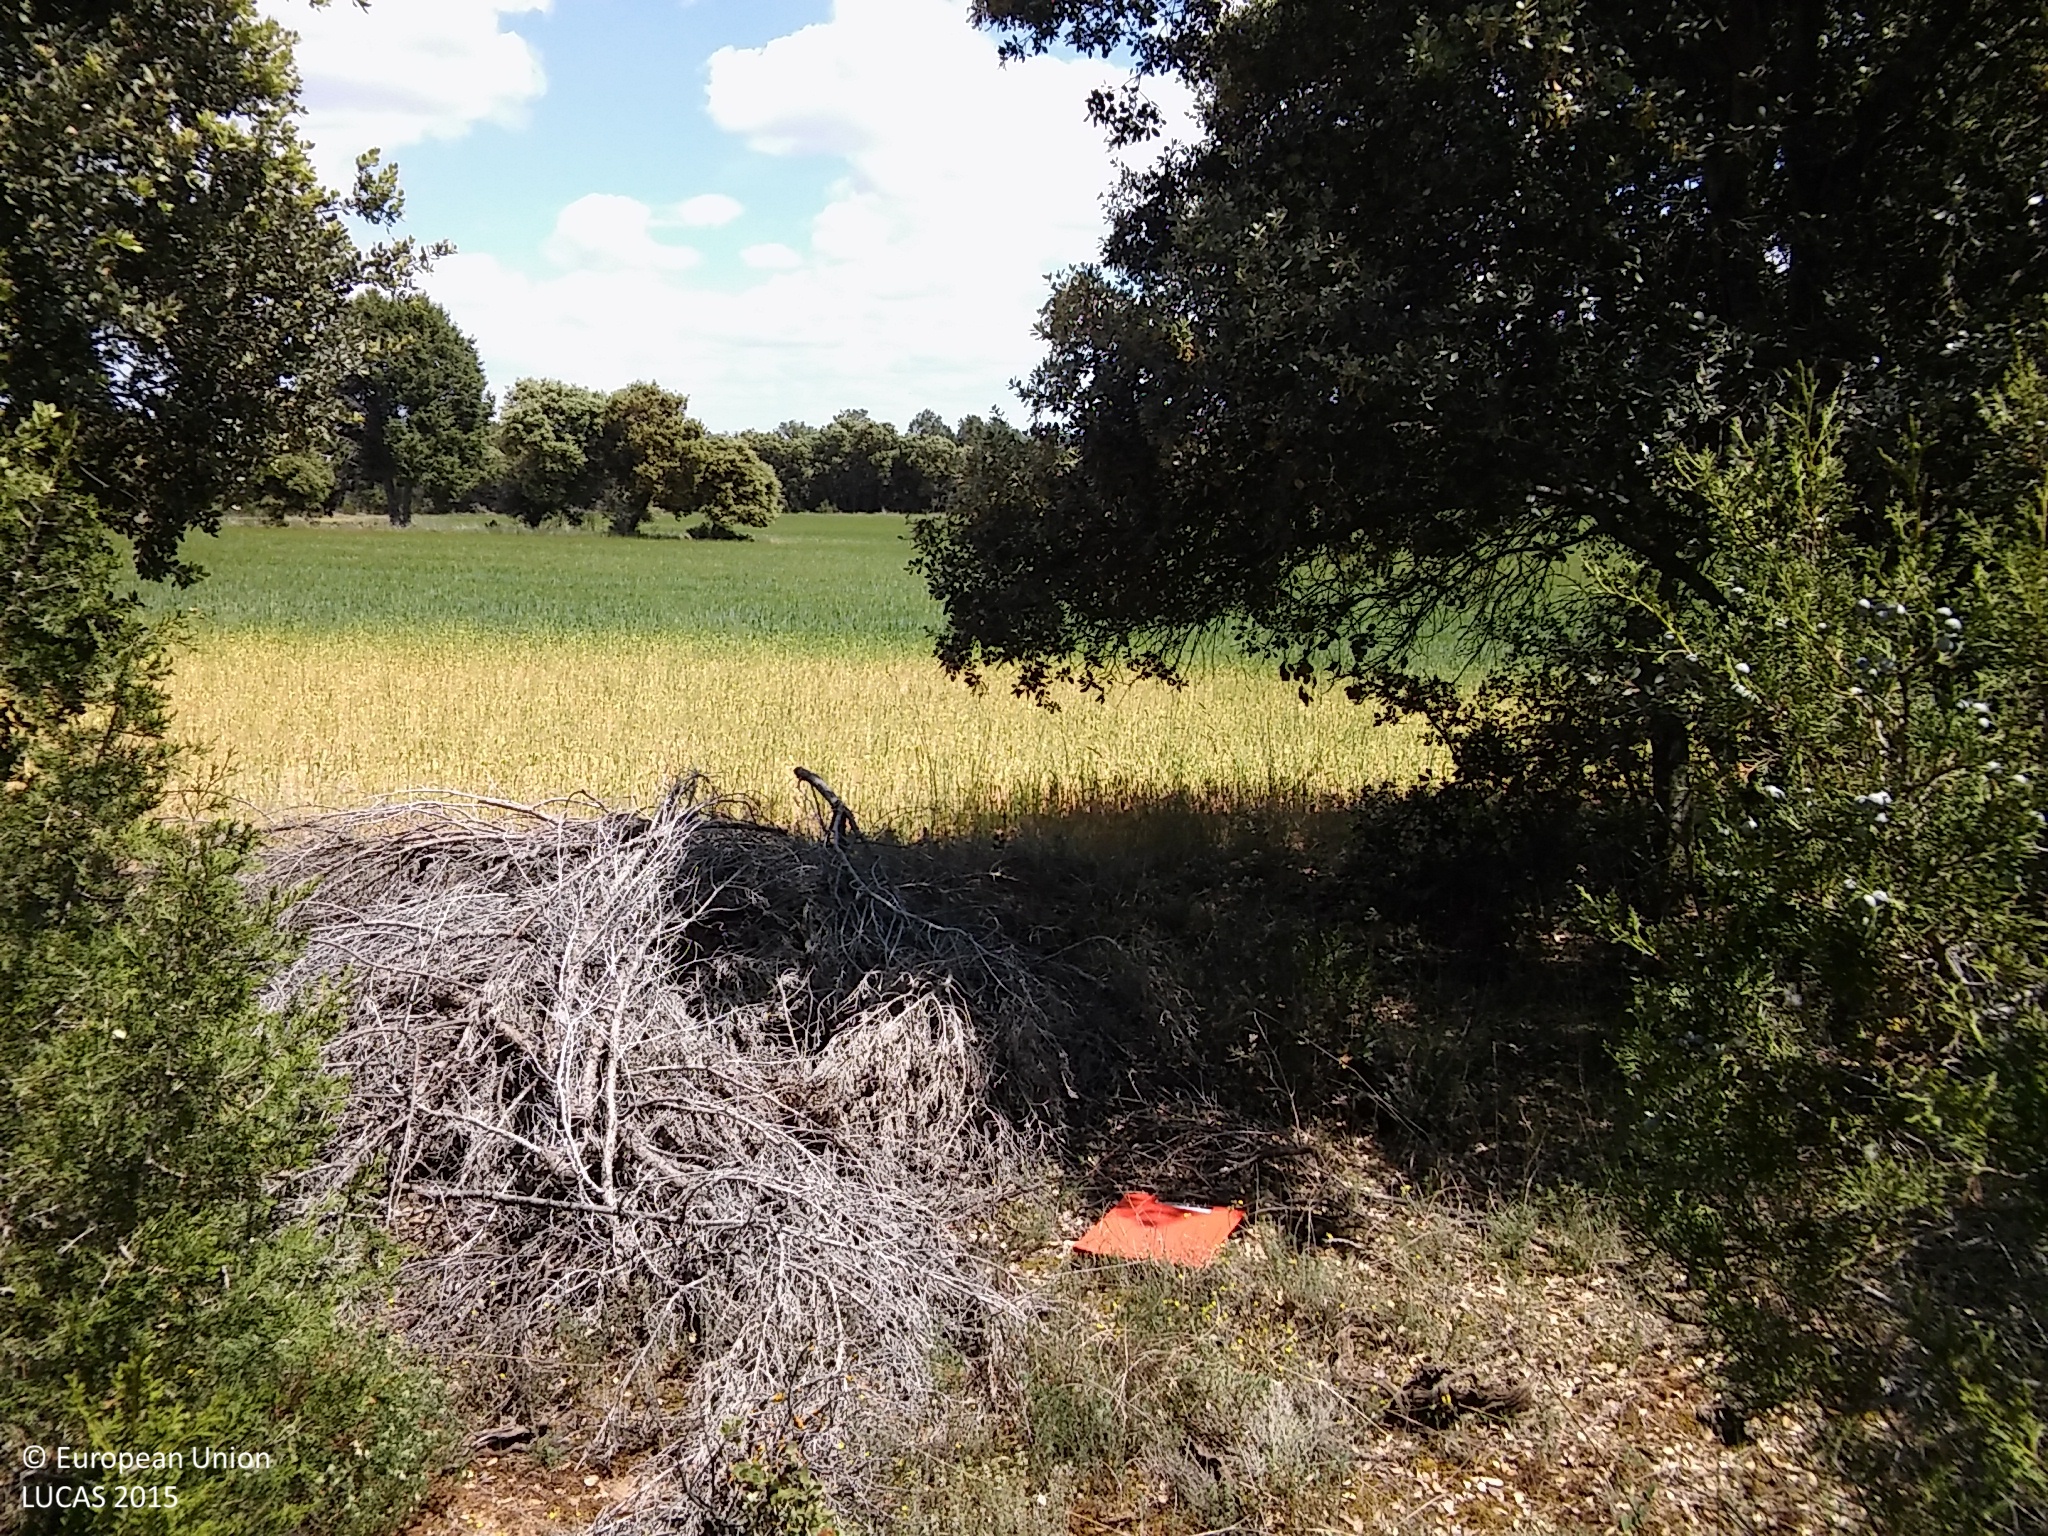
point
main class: Woodland
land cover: Other mixed woodland
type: coniferous forest of the mediterranean region
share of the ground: 25 - 50 %
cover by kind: coniferous forest trees 25 %, broadleaved forest trees 25 %, shrubs 25 %, unconsolidated bare surface 15 %, herbaceous plants 10 %
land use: Forestry
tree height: > 5 m
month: May
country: ES
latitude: 41.6075
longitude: -3.5736
